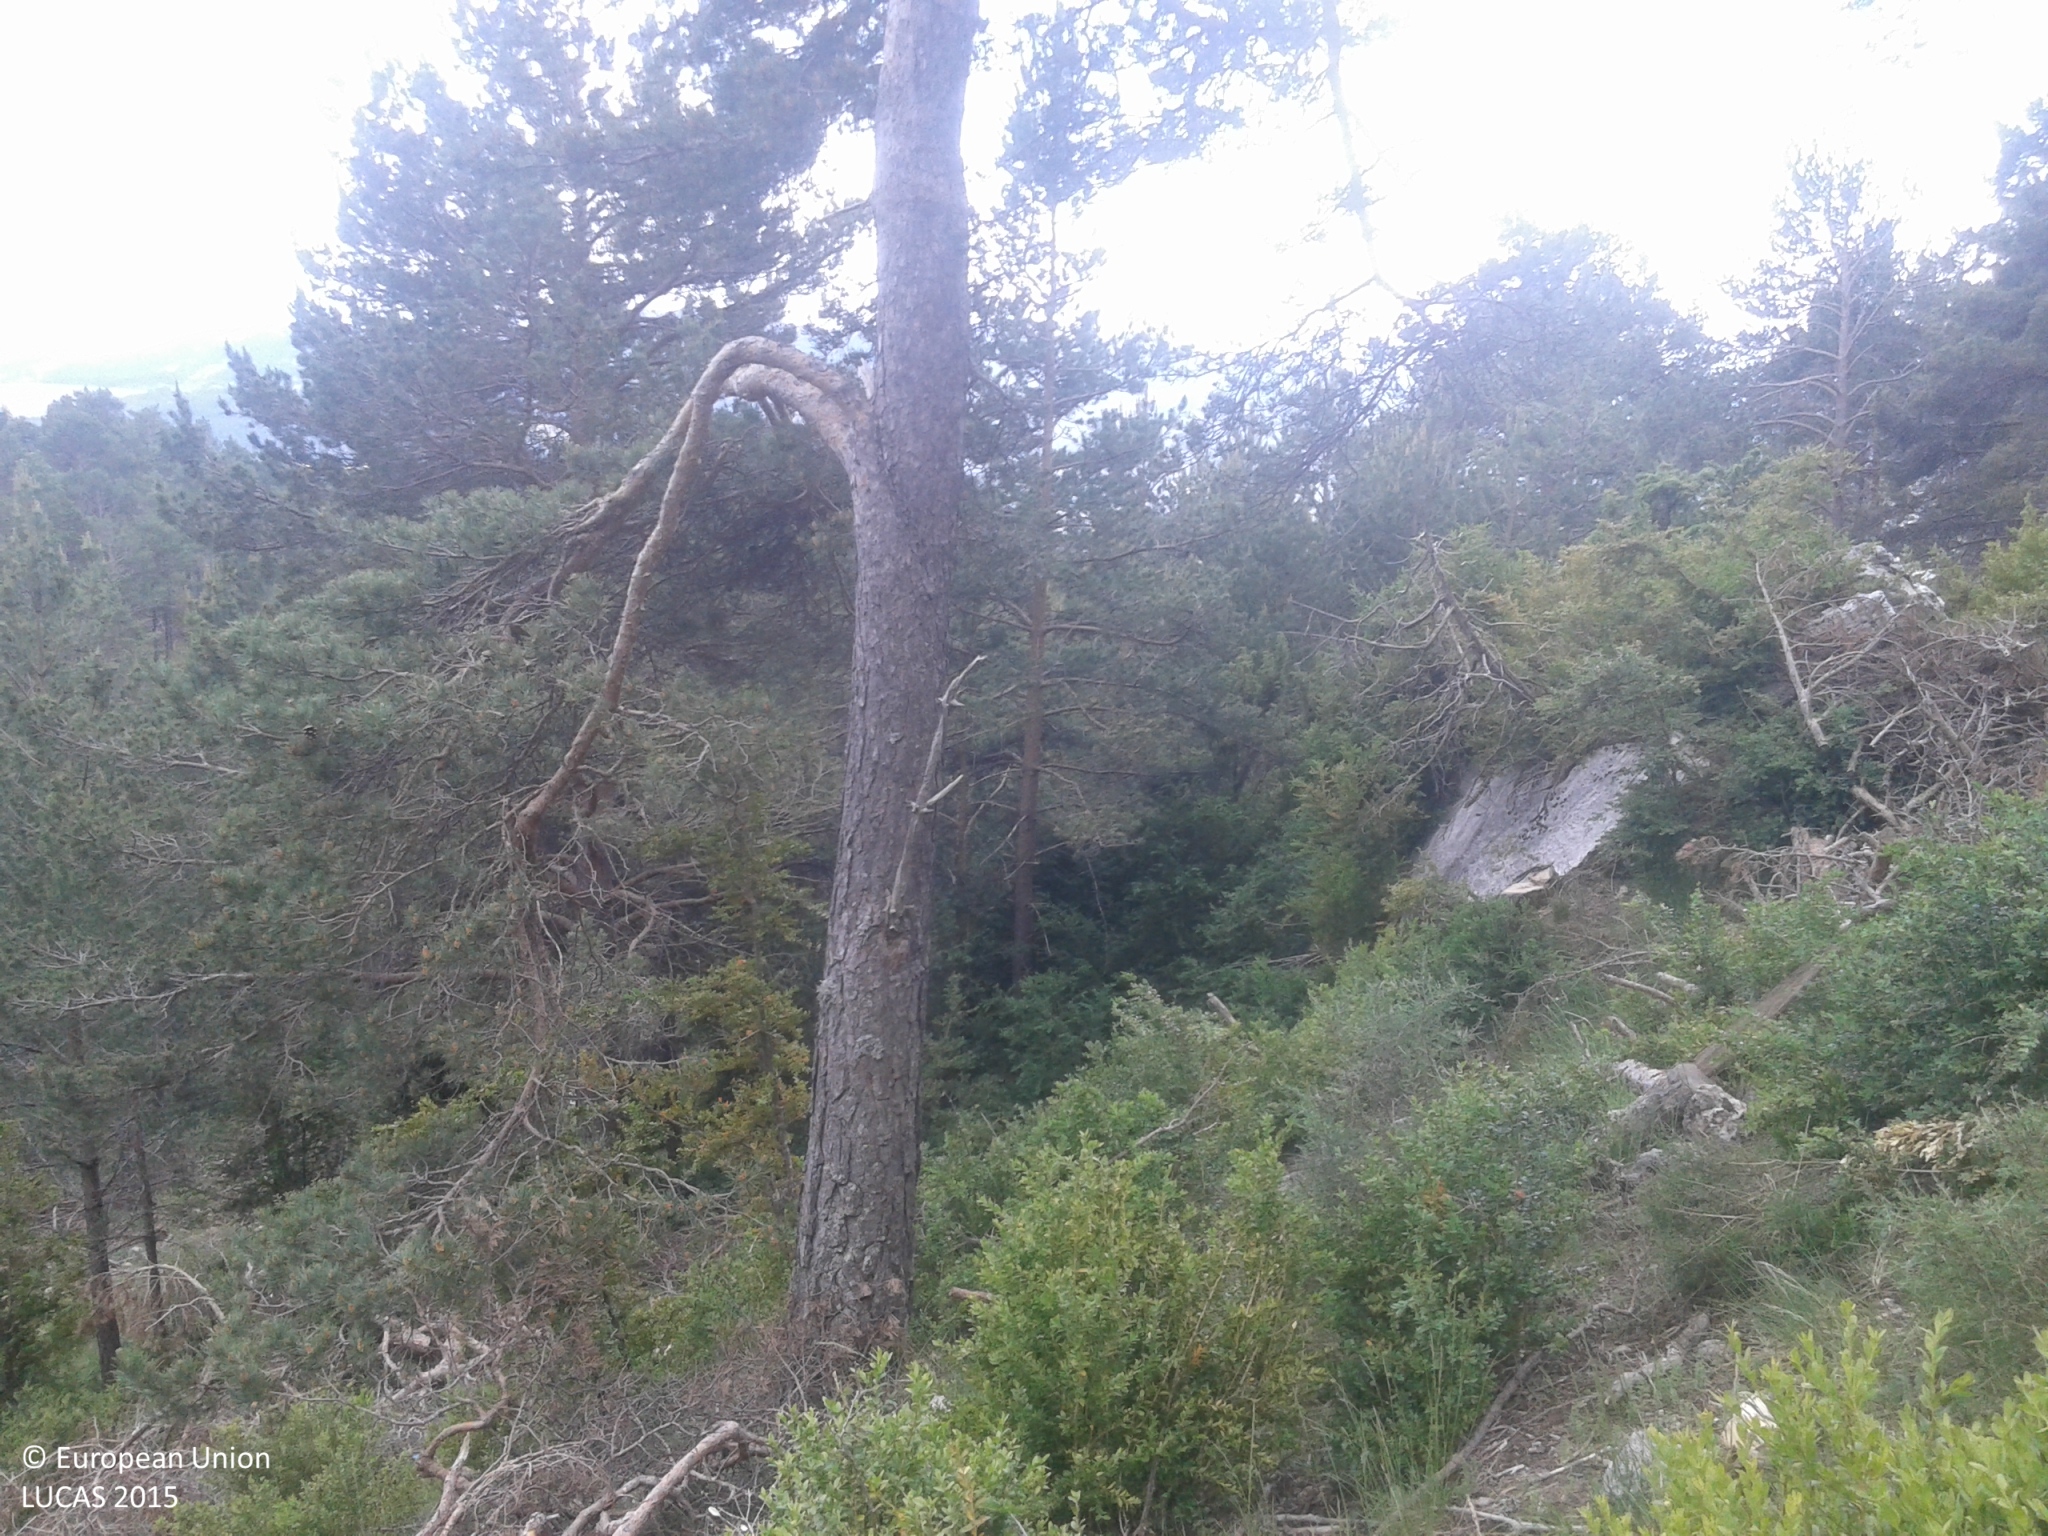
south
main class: Woodland
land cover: Pine dominated coniferous woodland
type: alpine coniferous forest
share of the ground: 50 - 75 %
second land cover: Shrubland without tree cover
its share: 50 - 75 %
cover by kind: coniferous forest trees 60 %, shrubs 35 %, herbaceous plants 5 %
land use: Forestry
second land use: Agriculture (excluding fallow land and kitchen gardens)
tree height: > 5 m
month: May
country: ES
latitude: 42.1354
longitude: 1.5306
